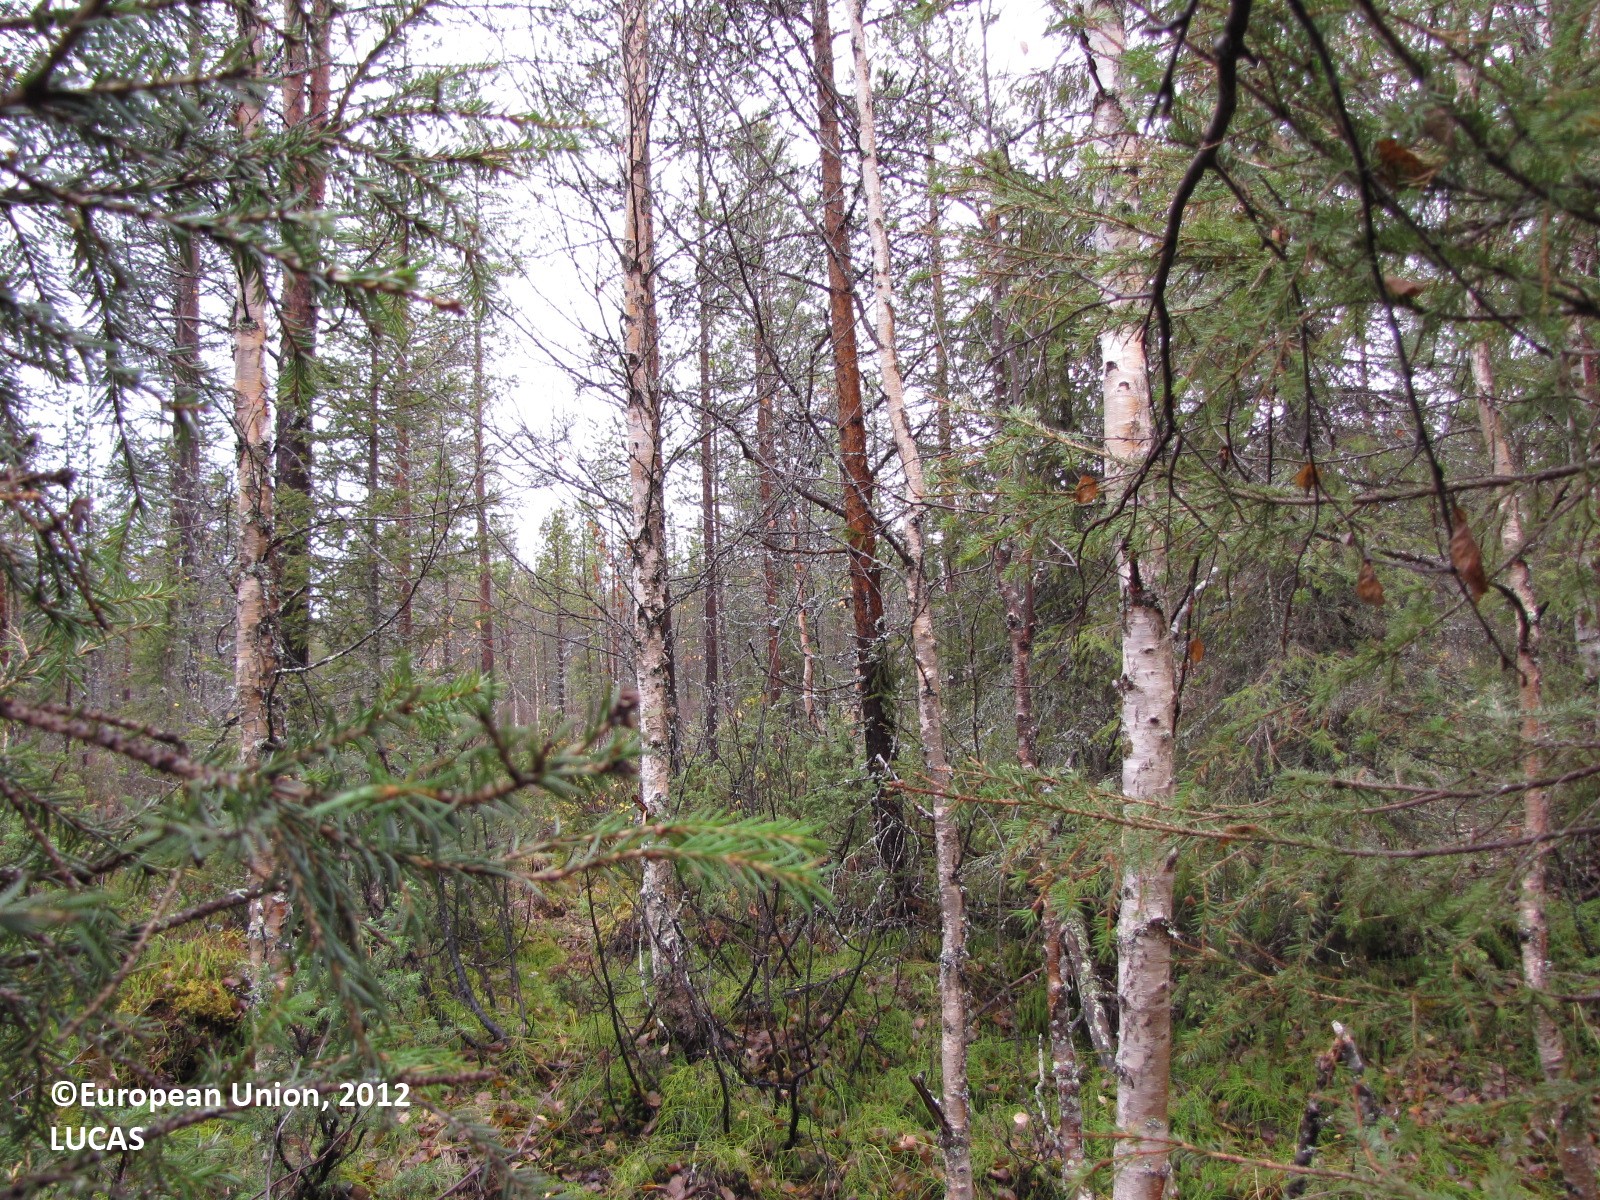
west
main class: Woodland
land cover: Spruce dominated mixed woodland
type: boreal forest
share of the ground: 50 - 75 %
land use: Forestry
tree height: > 5 m
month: September
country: FI
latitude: 67.4975
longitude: 25.3351
